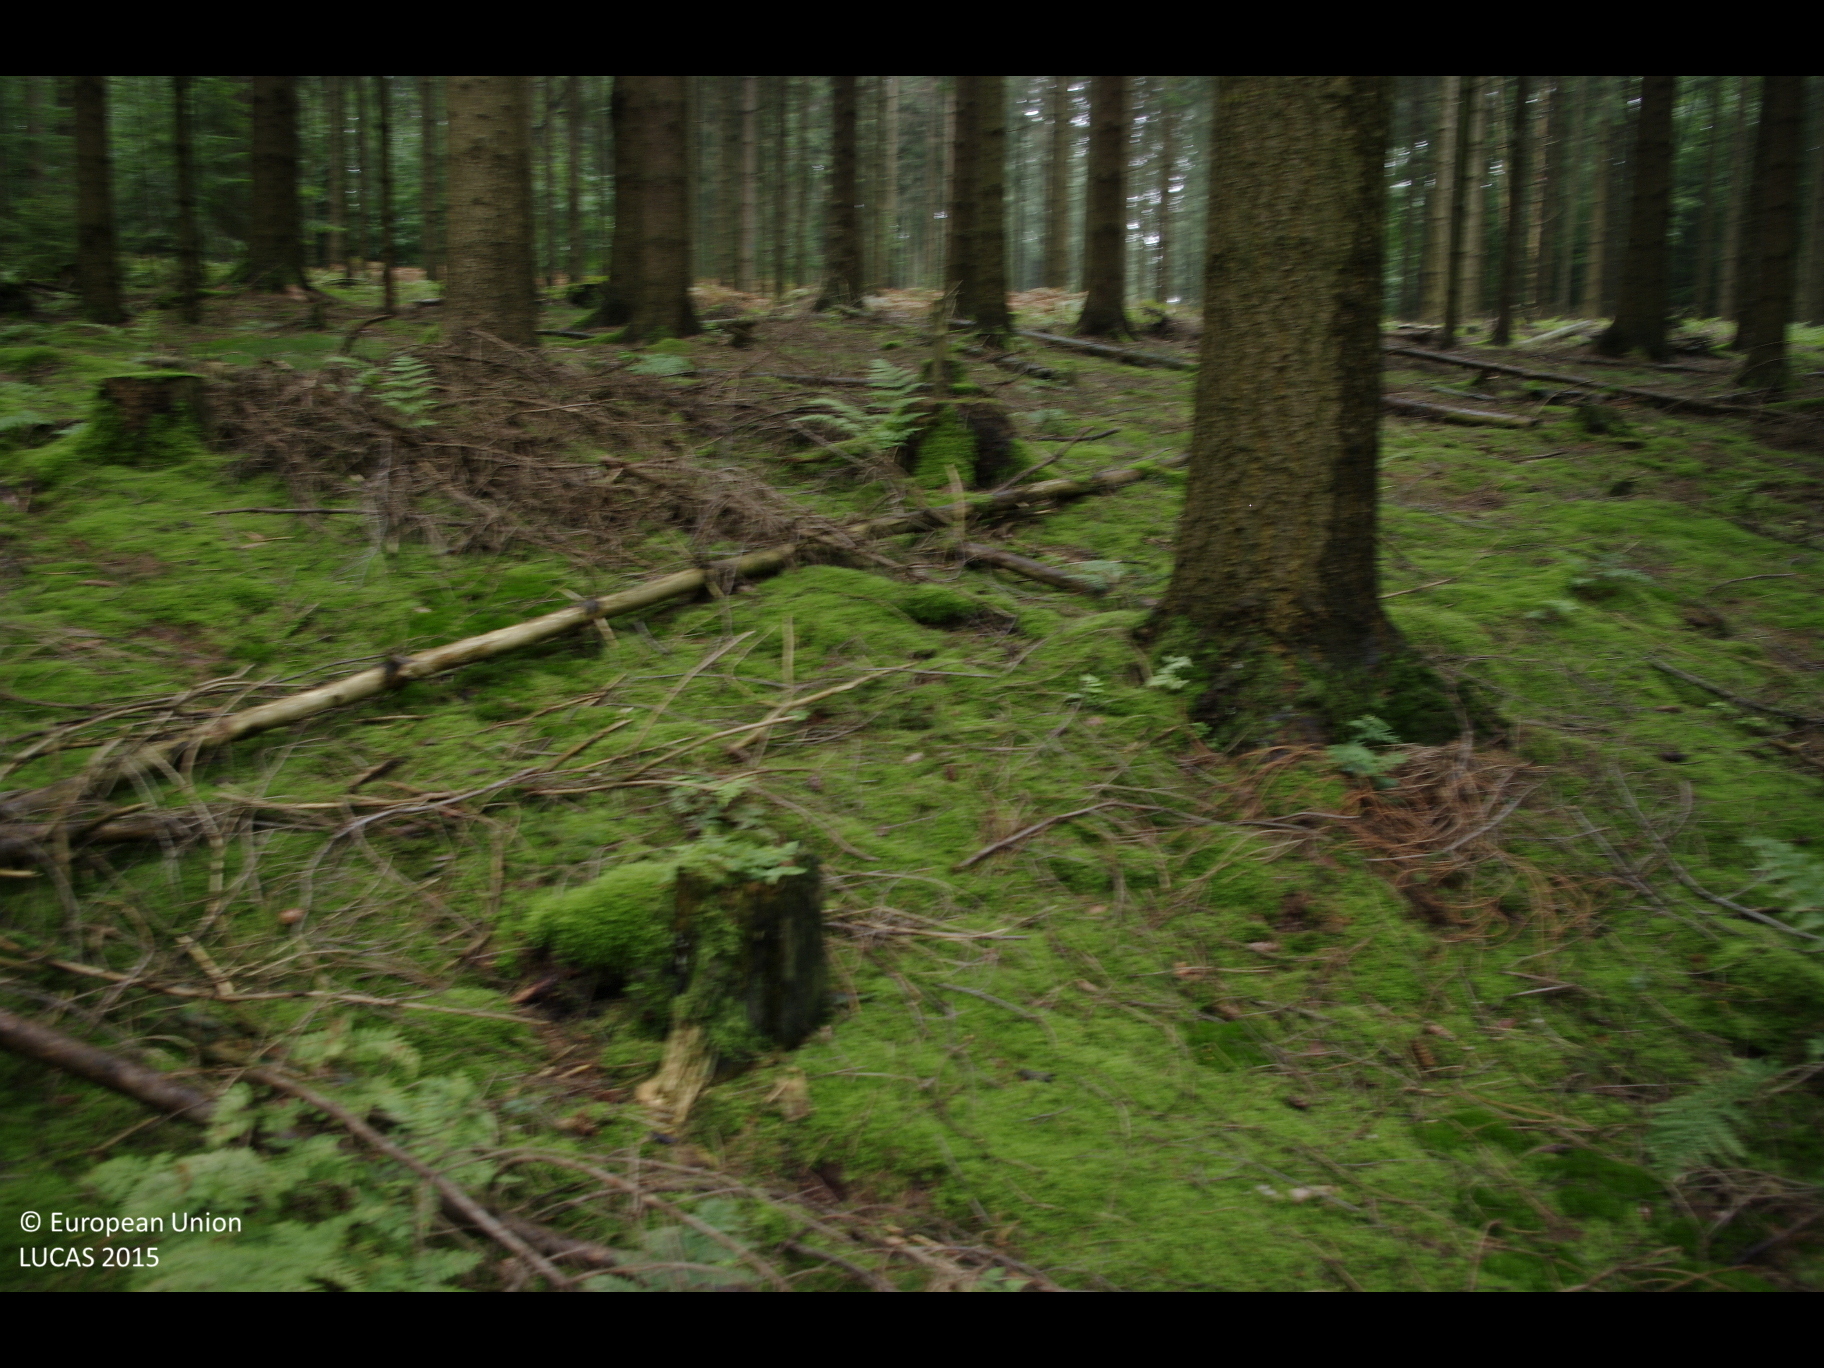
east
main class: Woodland
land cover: Other coniferous woodland
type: hemiboreal forest and nemoral coniferous forest and mixed broadleaved-coniferous forest
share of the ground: 50 - 75 %
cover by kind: coniferous forest trees 70 %, lichens and mosses 20 %, herbaceous plants 10 %
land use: Forestry
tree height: > 5 m
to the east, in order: Other coniferous woodland; Tracks; Other coniferous woodland; Other mixed woodland
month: September
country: DE
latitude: 53.4198
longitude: 9.8646
